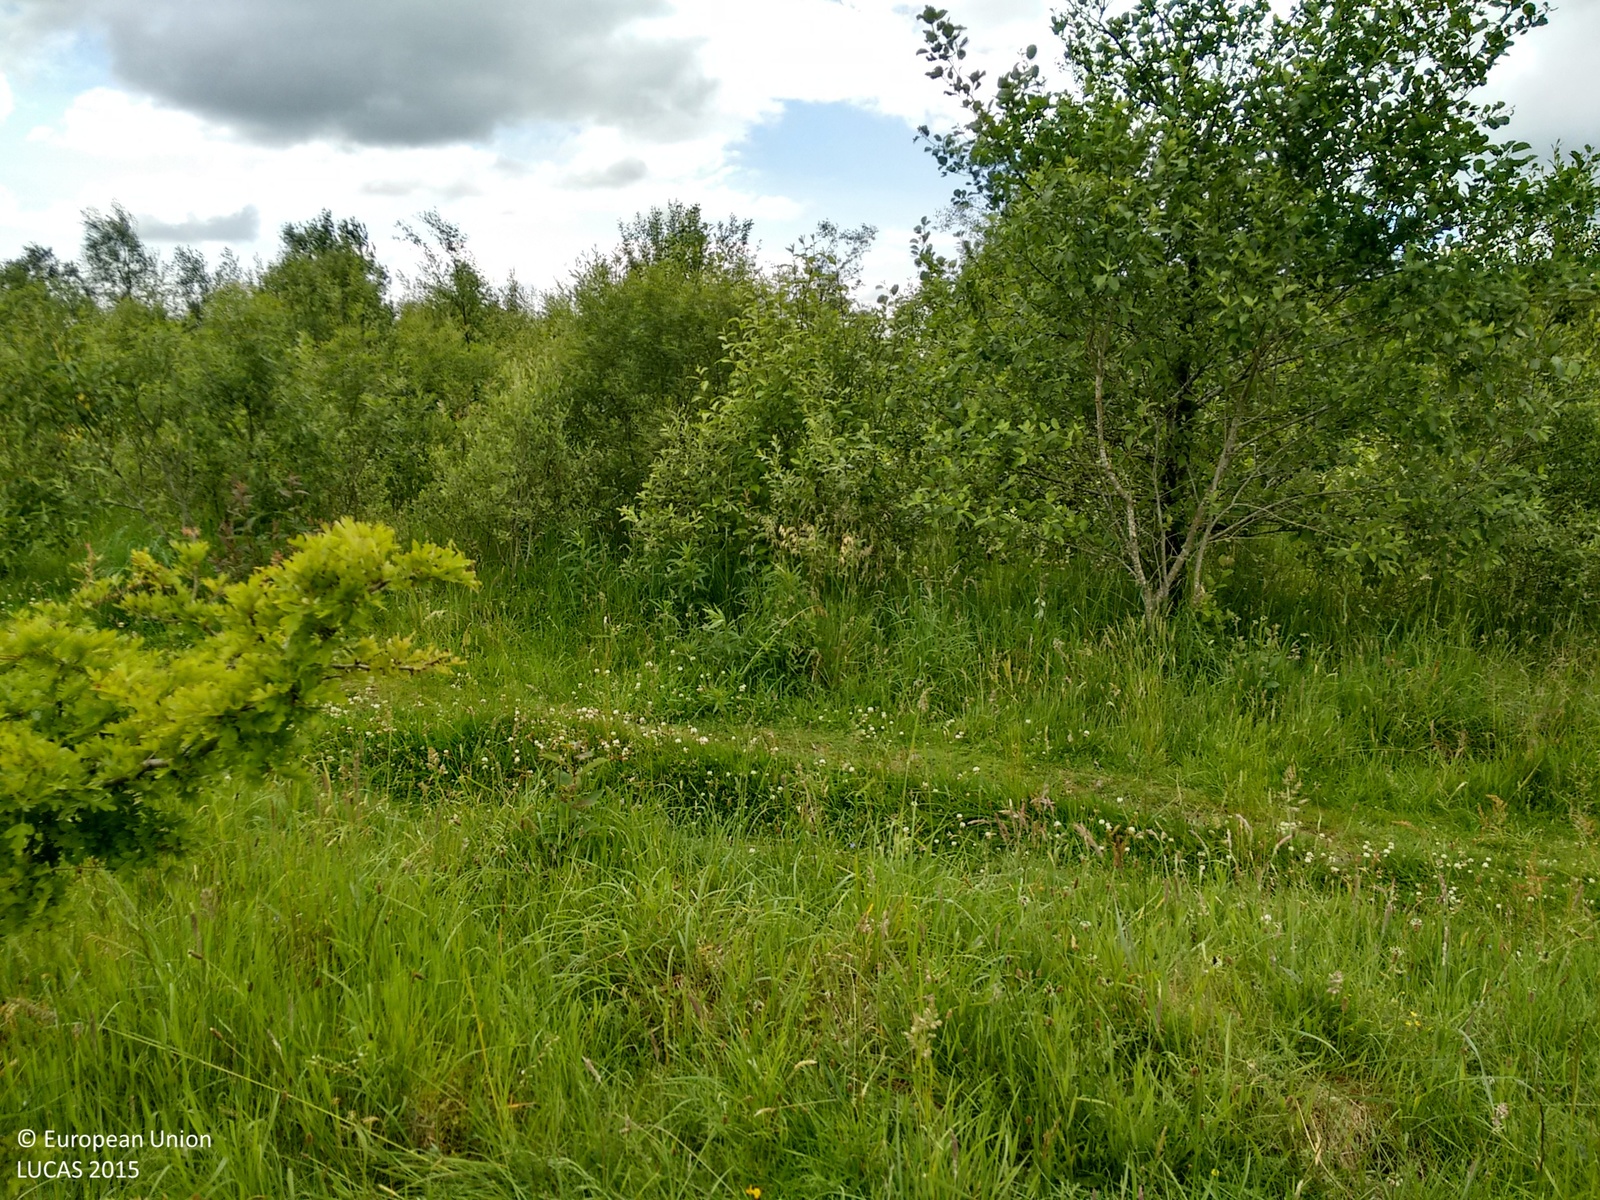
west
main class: Grassland
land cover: Grassland with sparse tree/shrub cover
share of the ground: 50 - 75 %
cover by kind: herbaceous plants 90 %, broadleaved forest trees 5 %, shrubs 5 %
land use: Amenities, museums, leisure
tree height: < 5 m
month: July
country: GB
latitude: 55.6112
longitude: -4.2065
